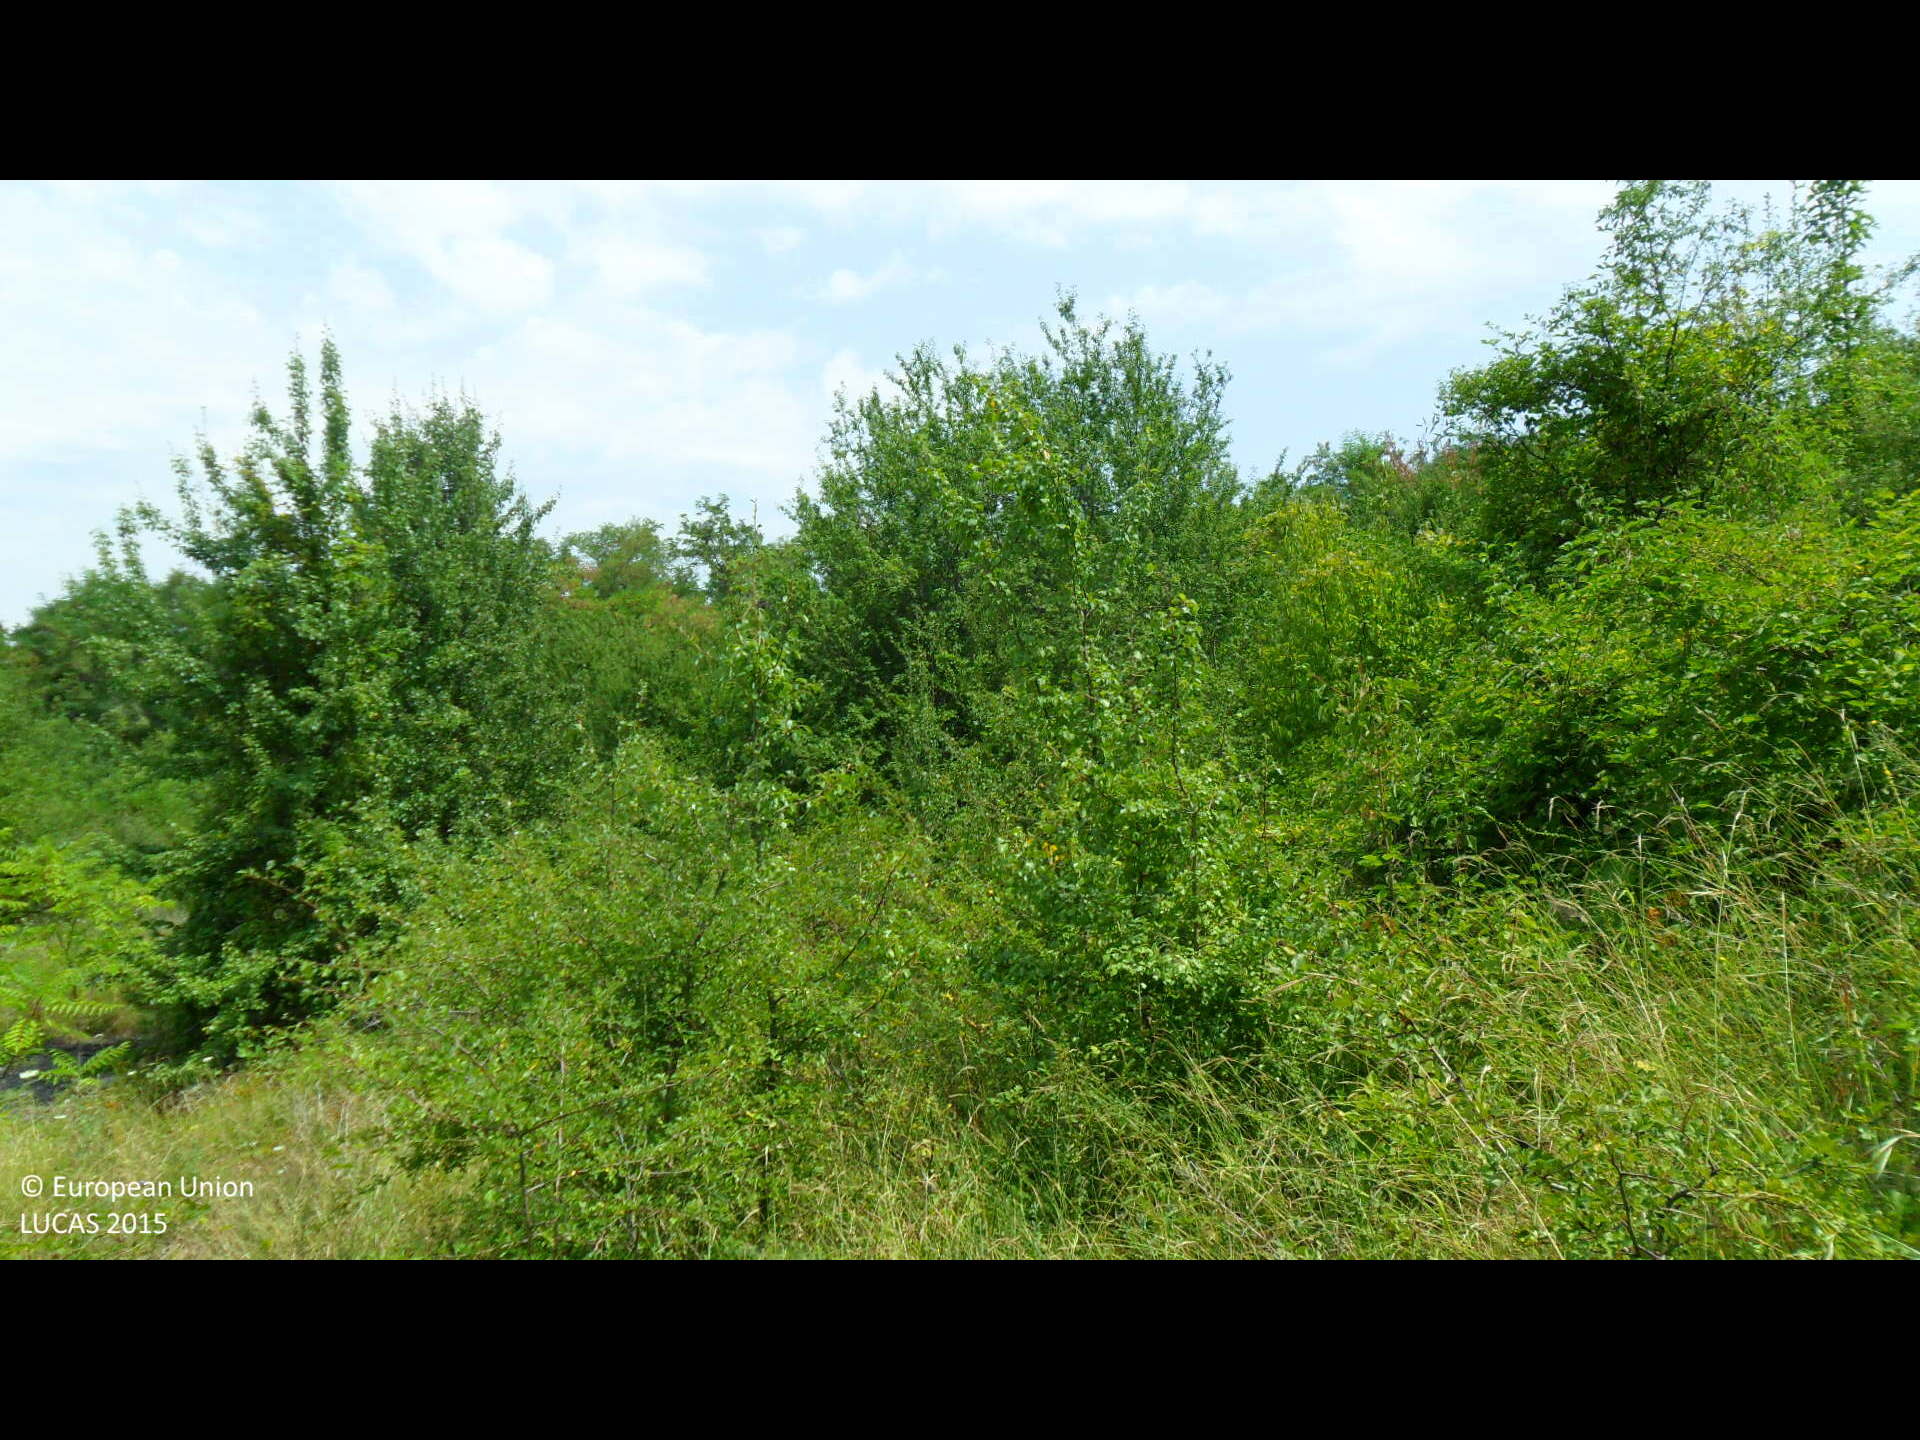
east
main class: Woodland
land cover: Broadleaved woodland
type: mesophytic deciduous forest
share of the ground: > 75 %
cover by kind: broadleaved forest trees 90 %, shrubs 10 %
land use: Forestry
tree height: > 5 m
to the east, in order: Broadleaved woodland
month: July
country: BG
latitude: 43.3596
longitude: 26.3244
